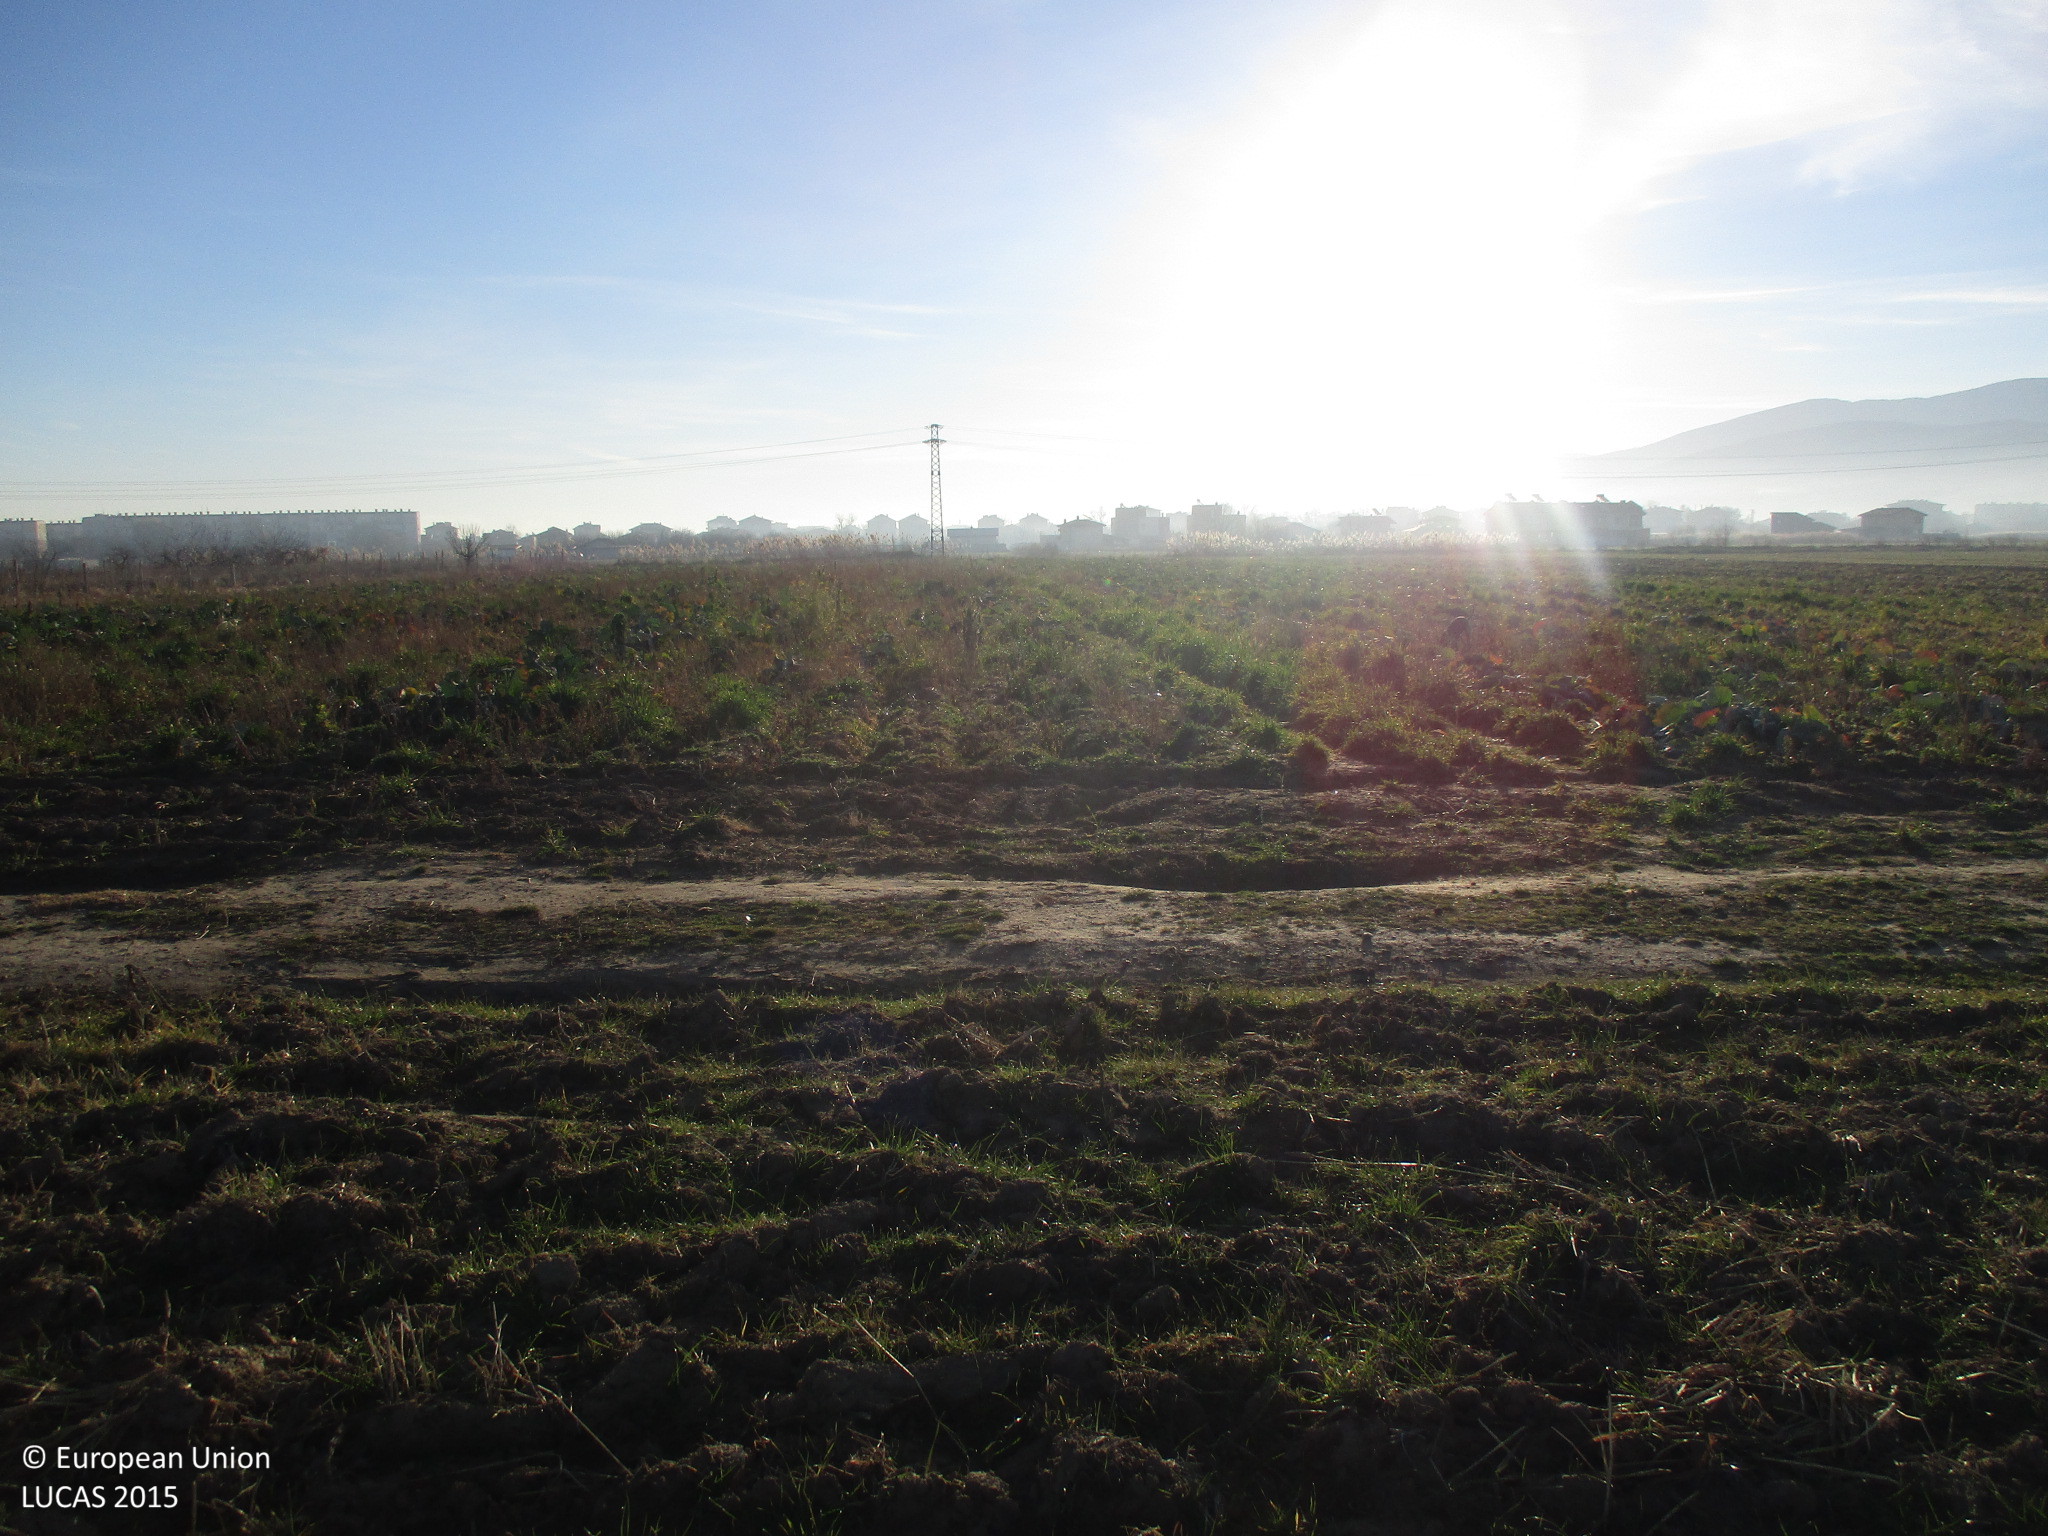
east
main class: Cropland
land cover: Common wheat
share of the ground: < 10 %
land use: Agriculture (excluding fallow land and kitchen gardens)
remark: Harvested field
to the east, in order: Common wheat; Tracks; Other fresh vegetables; Other fruit trees and berries; Fences; Spontaneously vegetated surfaces; Tracks; Electric lines; Shruby margins; Common wheat
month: December
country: BG
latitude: 42.1070
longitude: 24.6947
